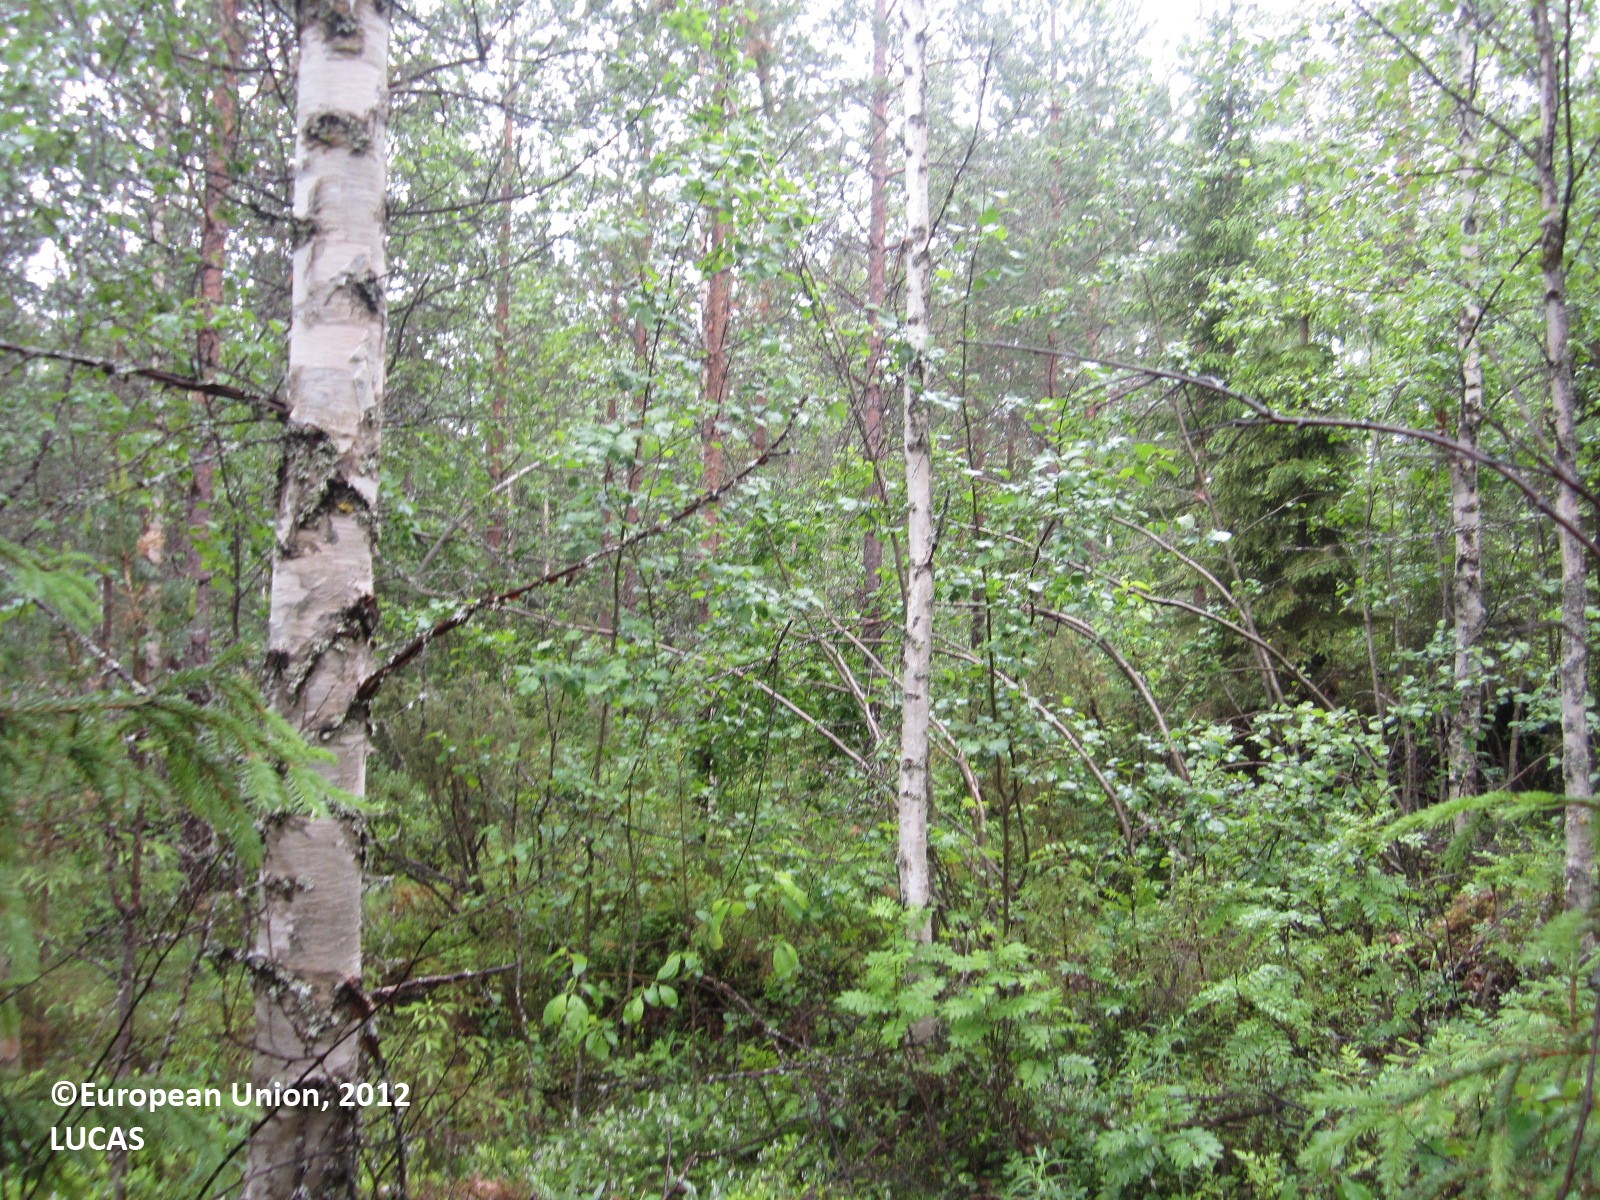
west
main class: Woodland
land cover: Pine dominated mixed woodland
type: boreal forest
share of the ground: > 75 %
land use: Forestry
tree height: > 5 m
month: June
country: FI
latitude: 64.5961
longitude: 29.3211
